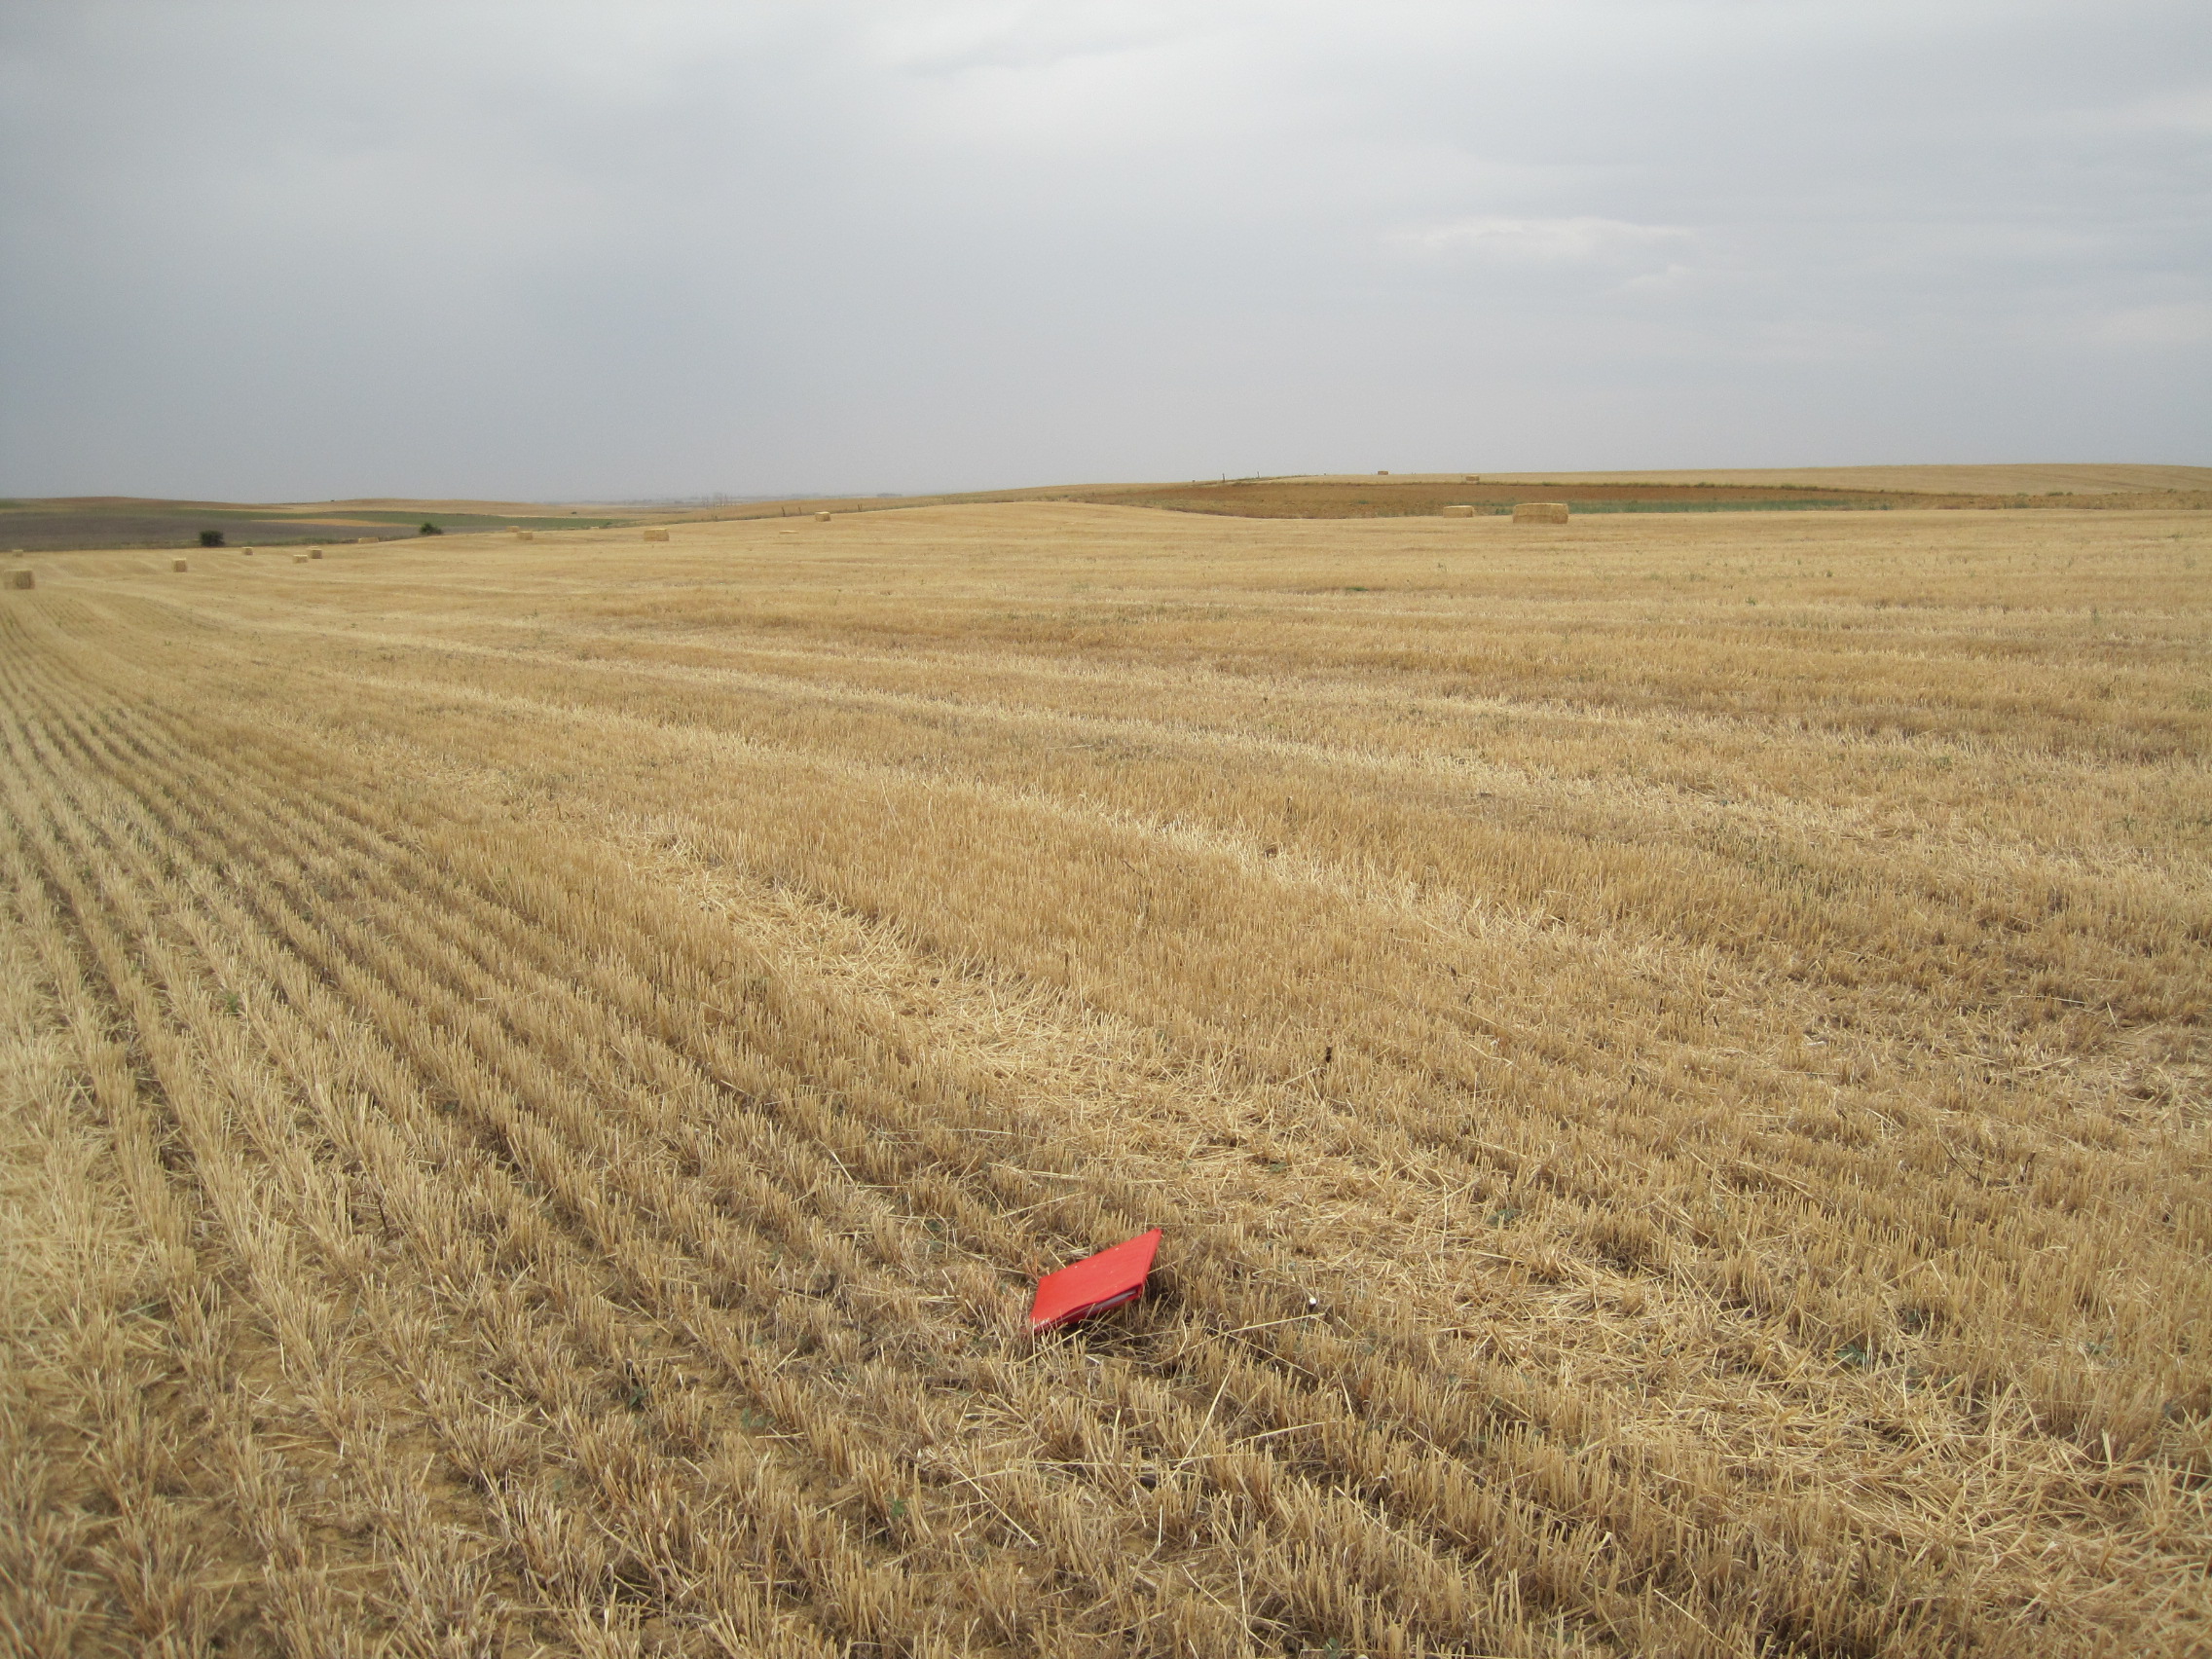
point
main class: Cropland
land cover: Barley
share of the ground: < 10 %
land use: Agriculture (excluding fallow land and kitchen gardens)
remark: Harvested field
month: July
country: ES
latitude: 41.7934
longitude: -5.5500
